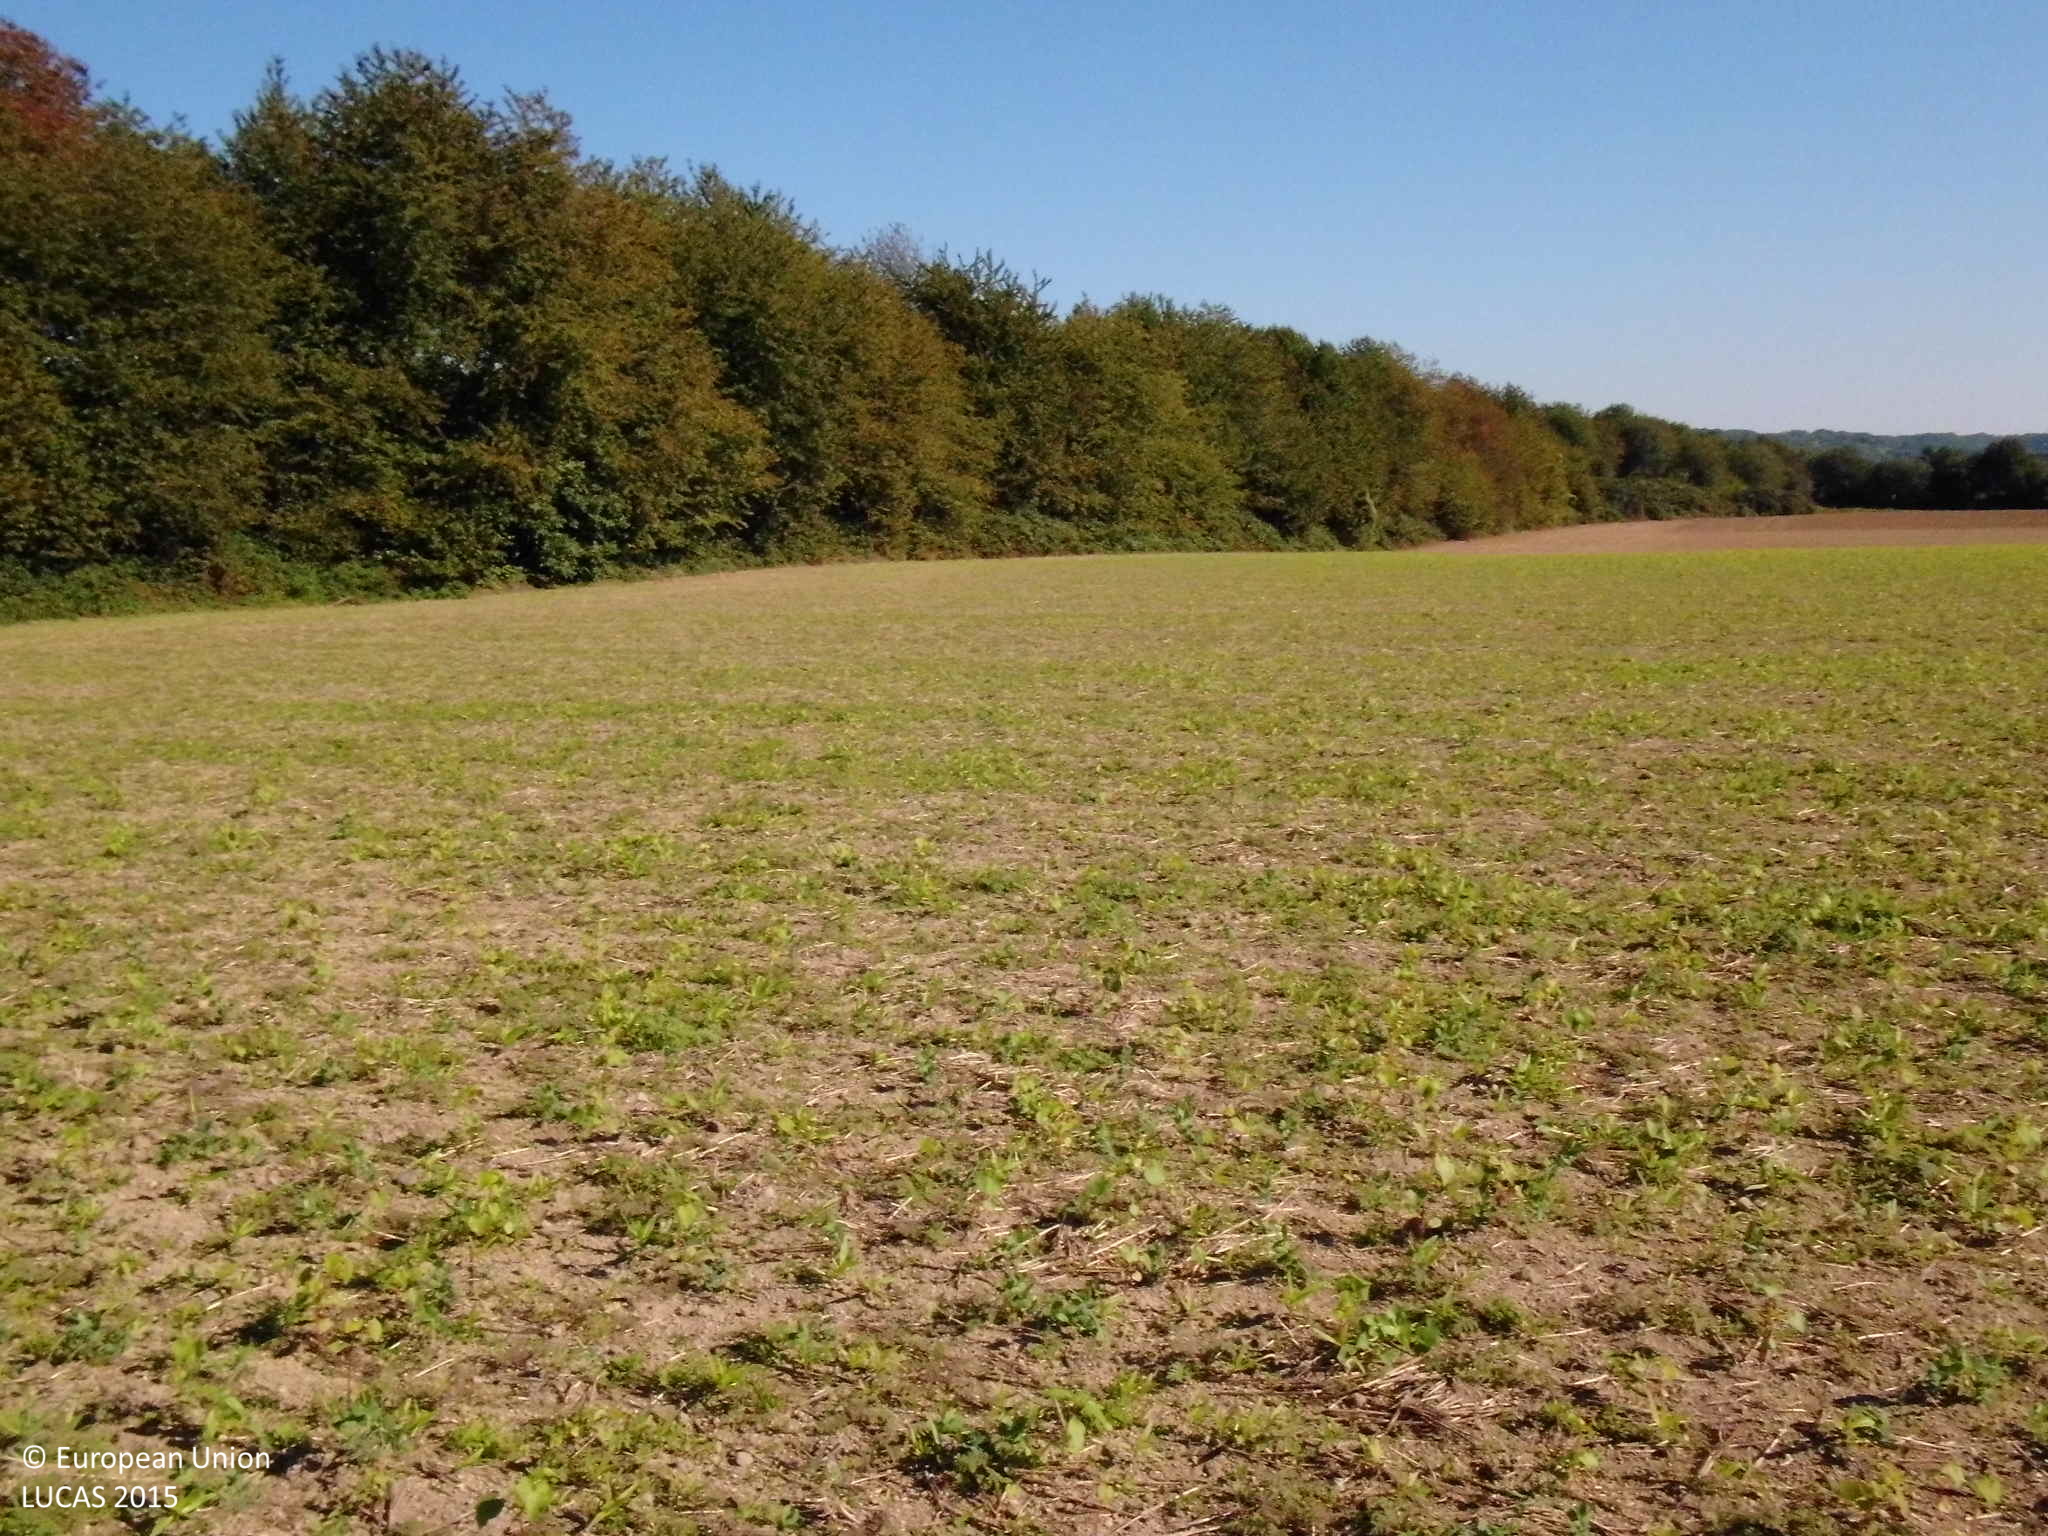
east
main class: Cropland
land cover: Other cereals
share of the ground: 10 - 25 %
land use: Agriculture (excluding fallow land and kitchen gardens)
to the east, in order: Other cereals; Broadleaved woodland; Grass margins; Tracks; Grass margins; Broadleaved woodland; Other root crops; Tracks; Other root crops
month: October
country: DE
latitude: 50.4455
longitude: 7.5359
